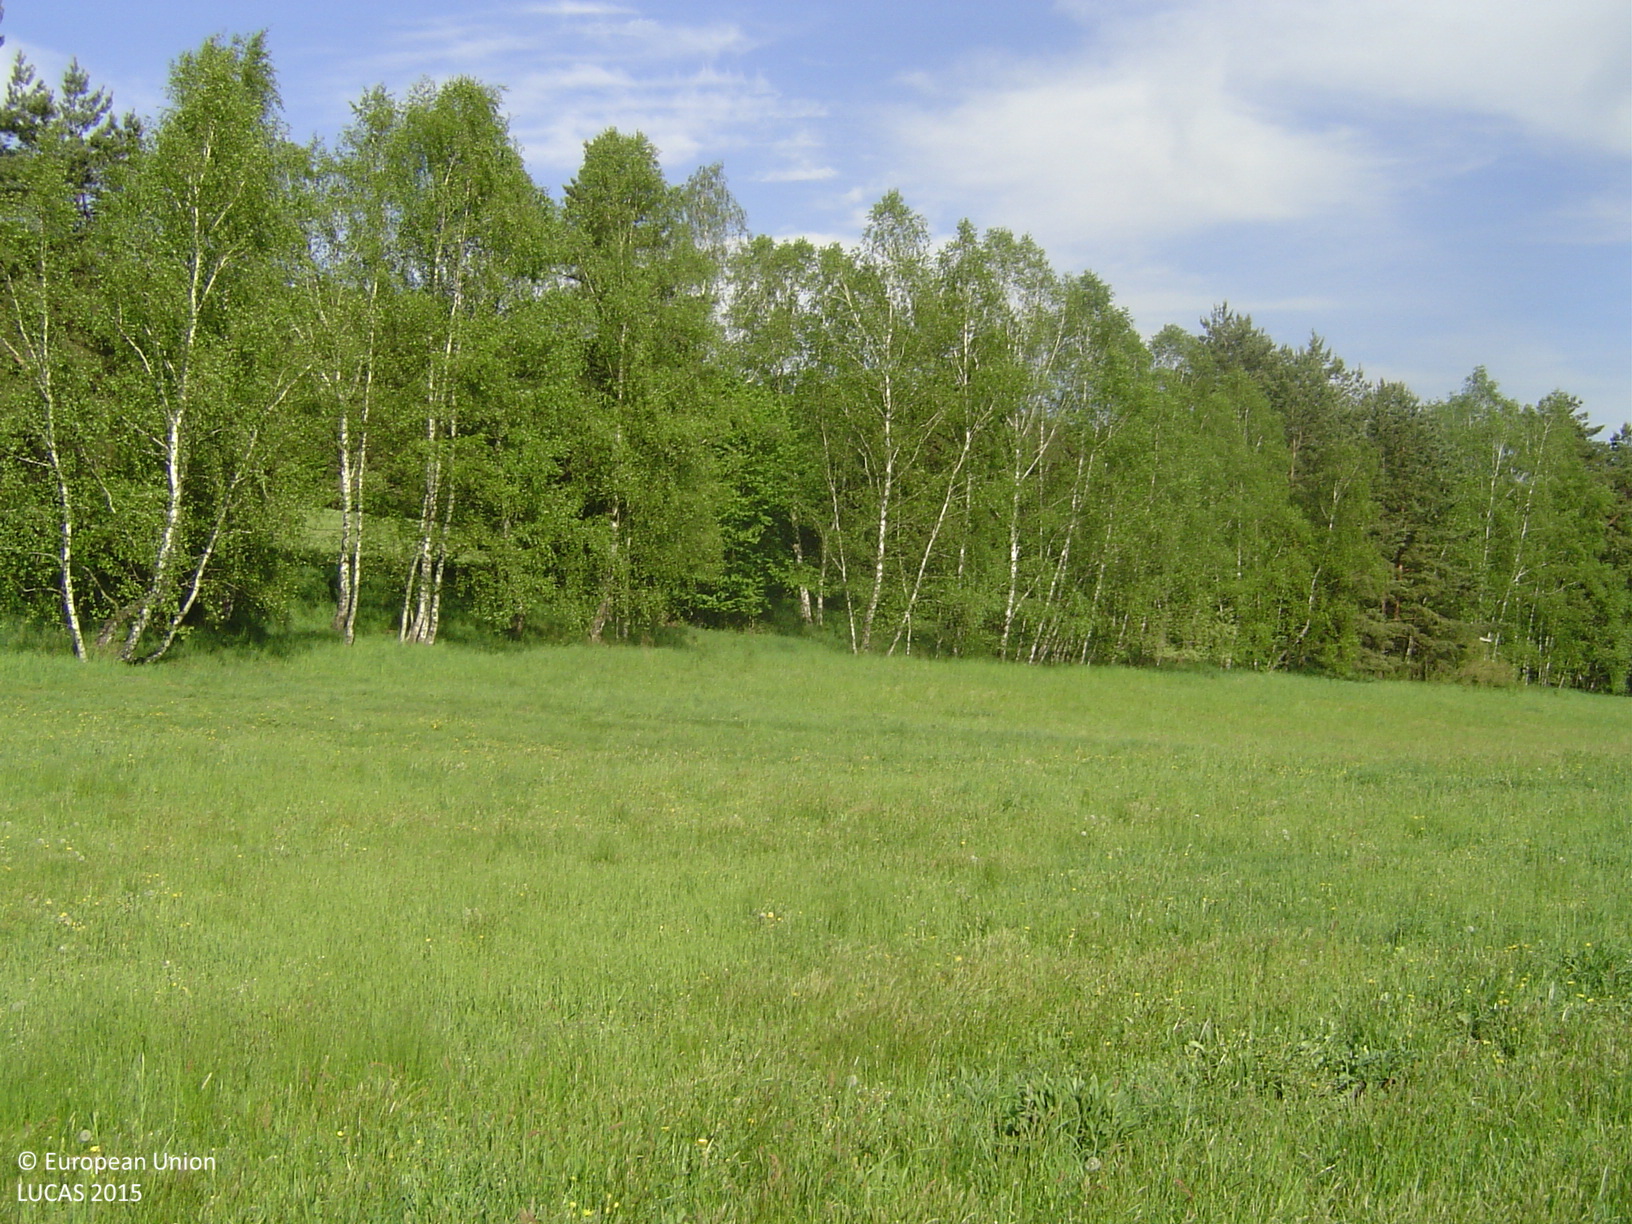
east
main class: Grassland
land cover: Grassland without tree/shrub cover
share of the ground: > 75 %
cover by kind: herbaceous plants 100 %
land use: Agriculture (excluding fallow land and kitchen gardens)
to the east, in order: Grassland without tree/shrub cover; Broadleaved woodland; Tracks; Broadleaved woodland; Grassland without tree/shrub cover; Other mixed woodland; Spruce dominated coniferous woodland
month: May
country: CZ
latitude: 49.4518
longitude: 16.2827
